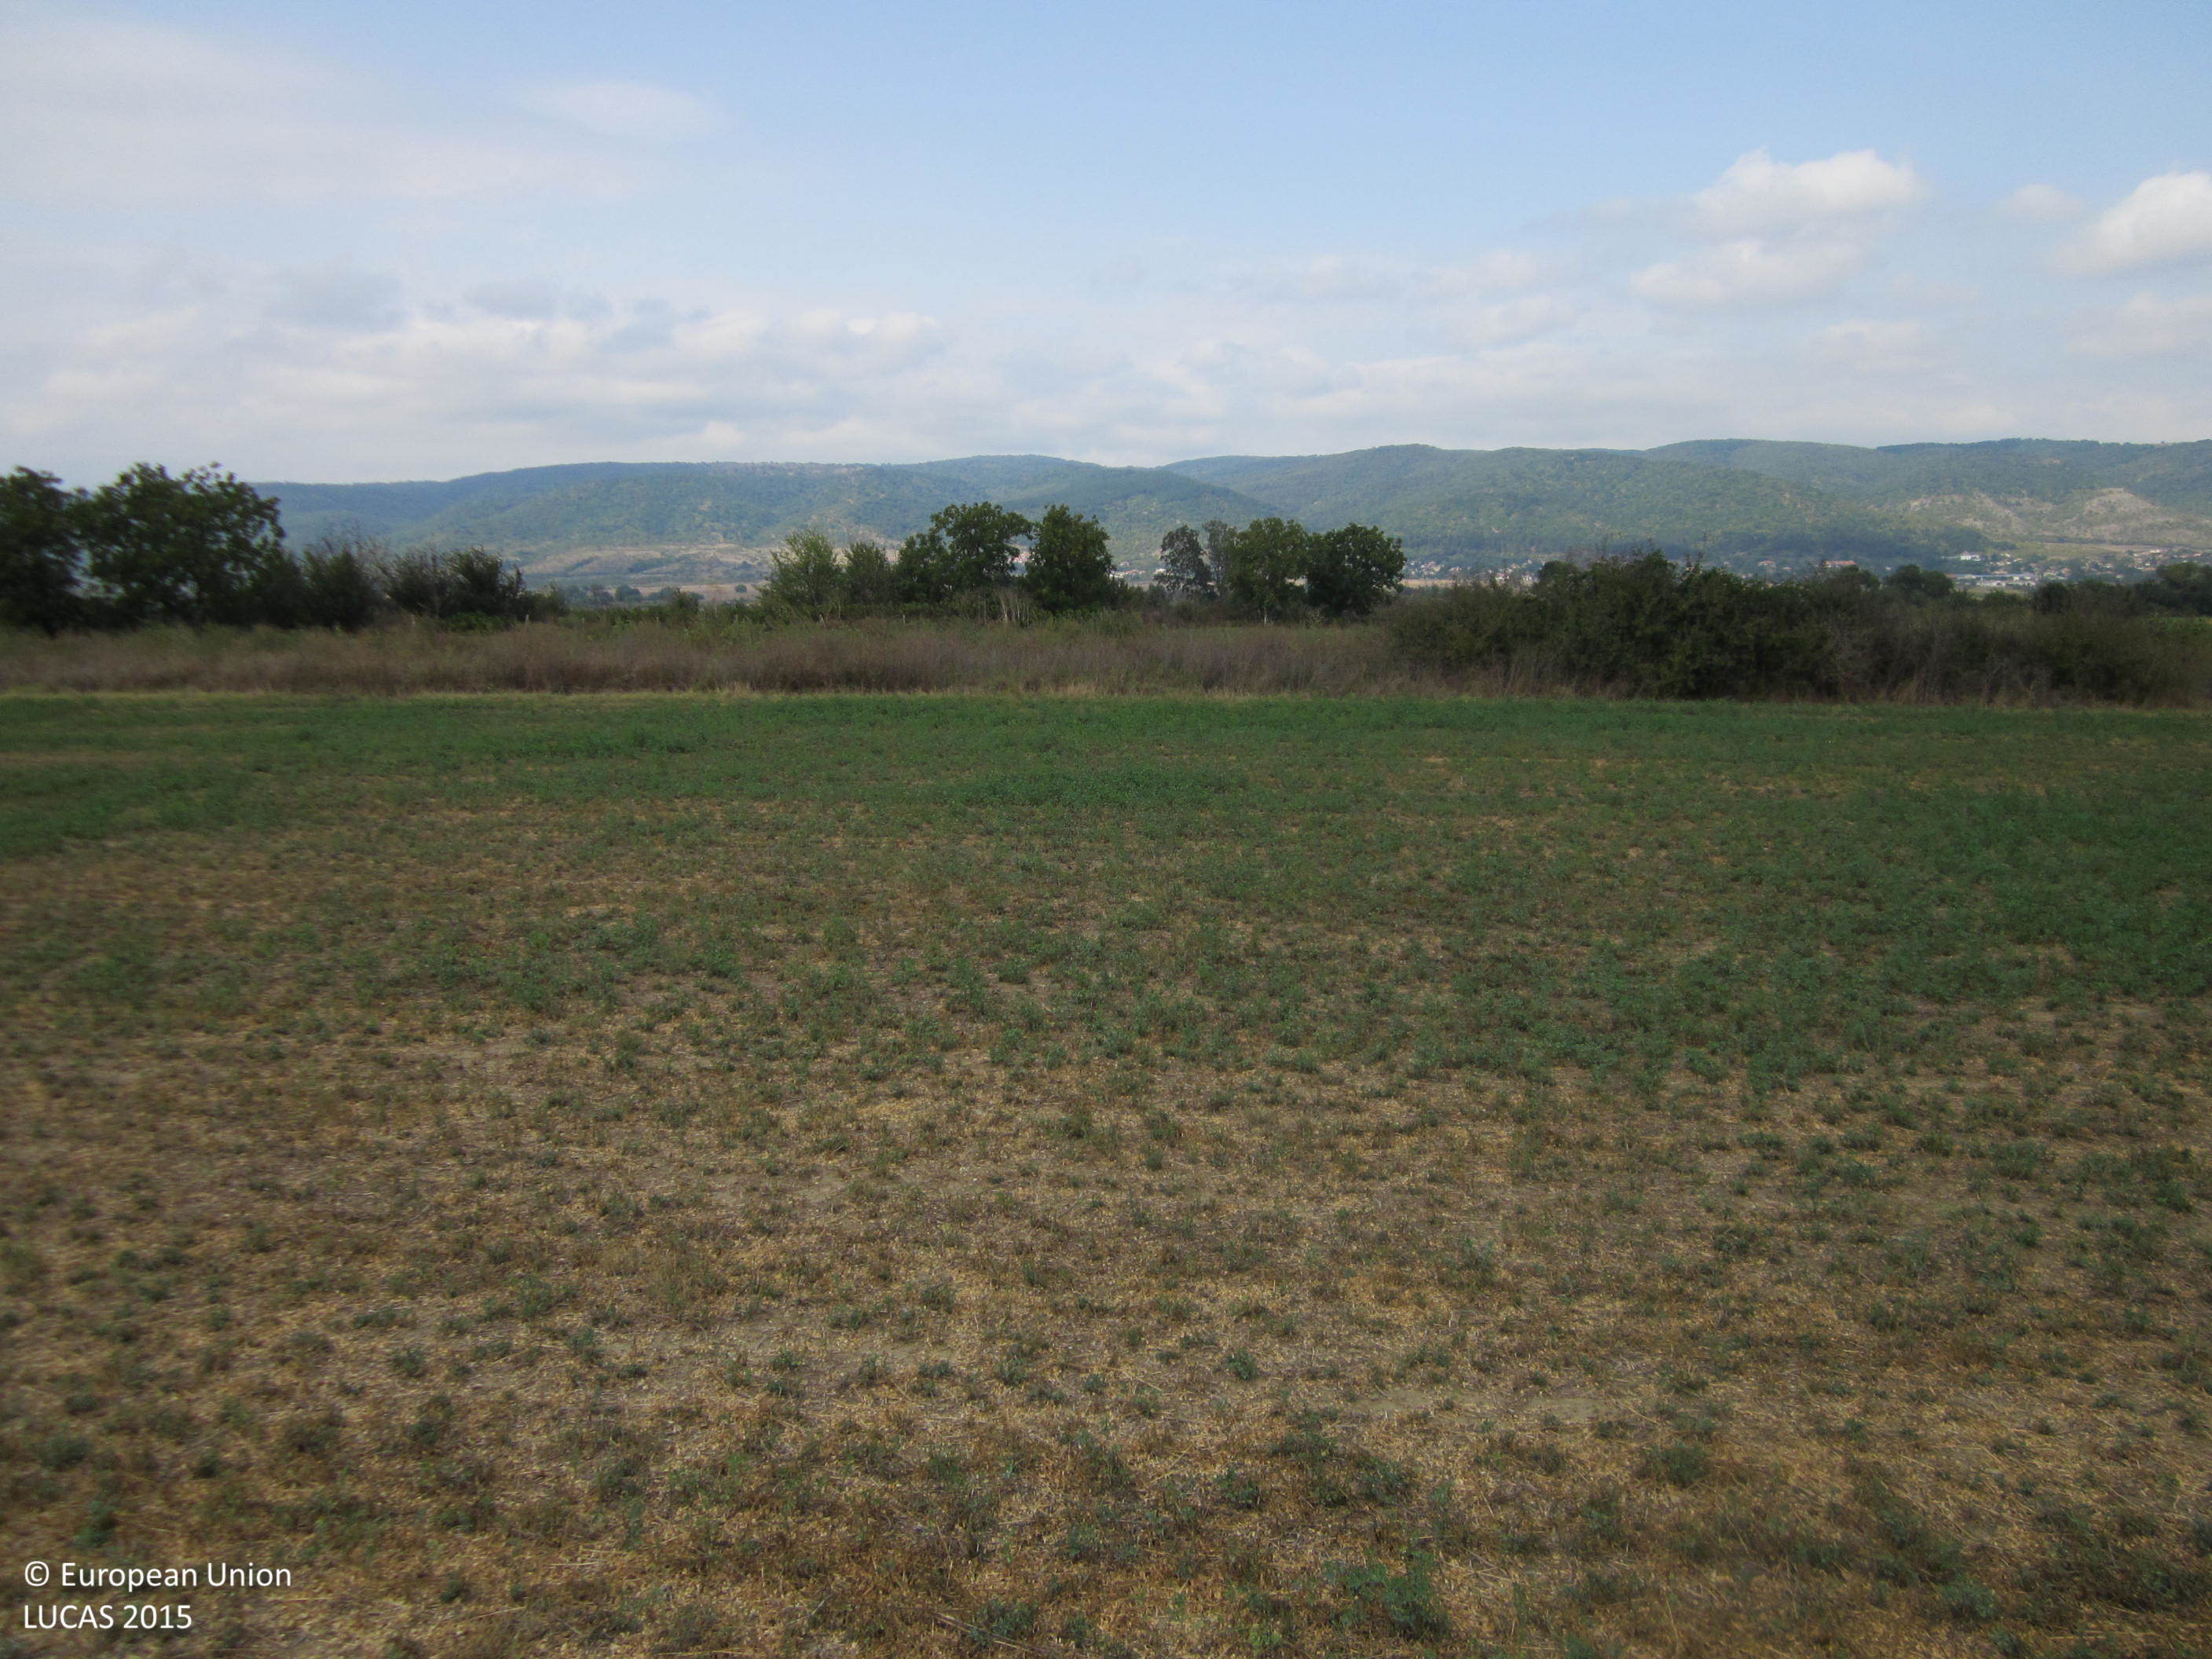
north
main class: Cropland
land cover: Lucerne
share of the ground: 50 - 75 %
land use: Agriculture (excluding fallow land and kitchen gardens)
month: September
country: BG
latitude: 42.7731
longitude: 27.5136
